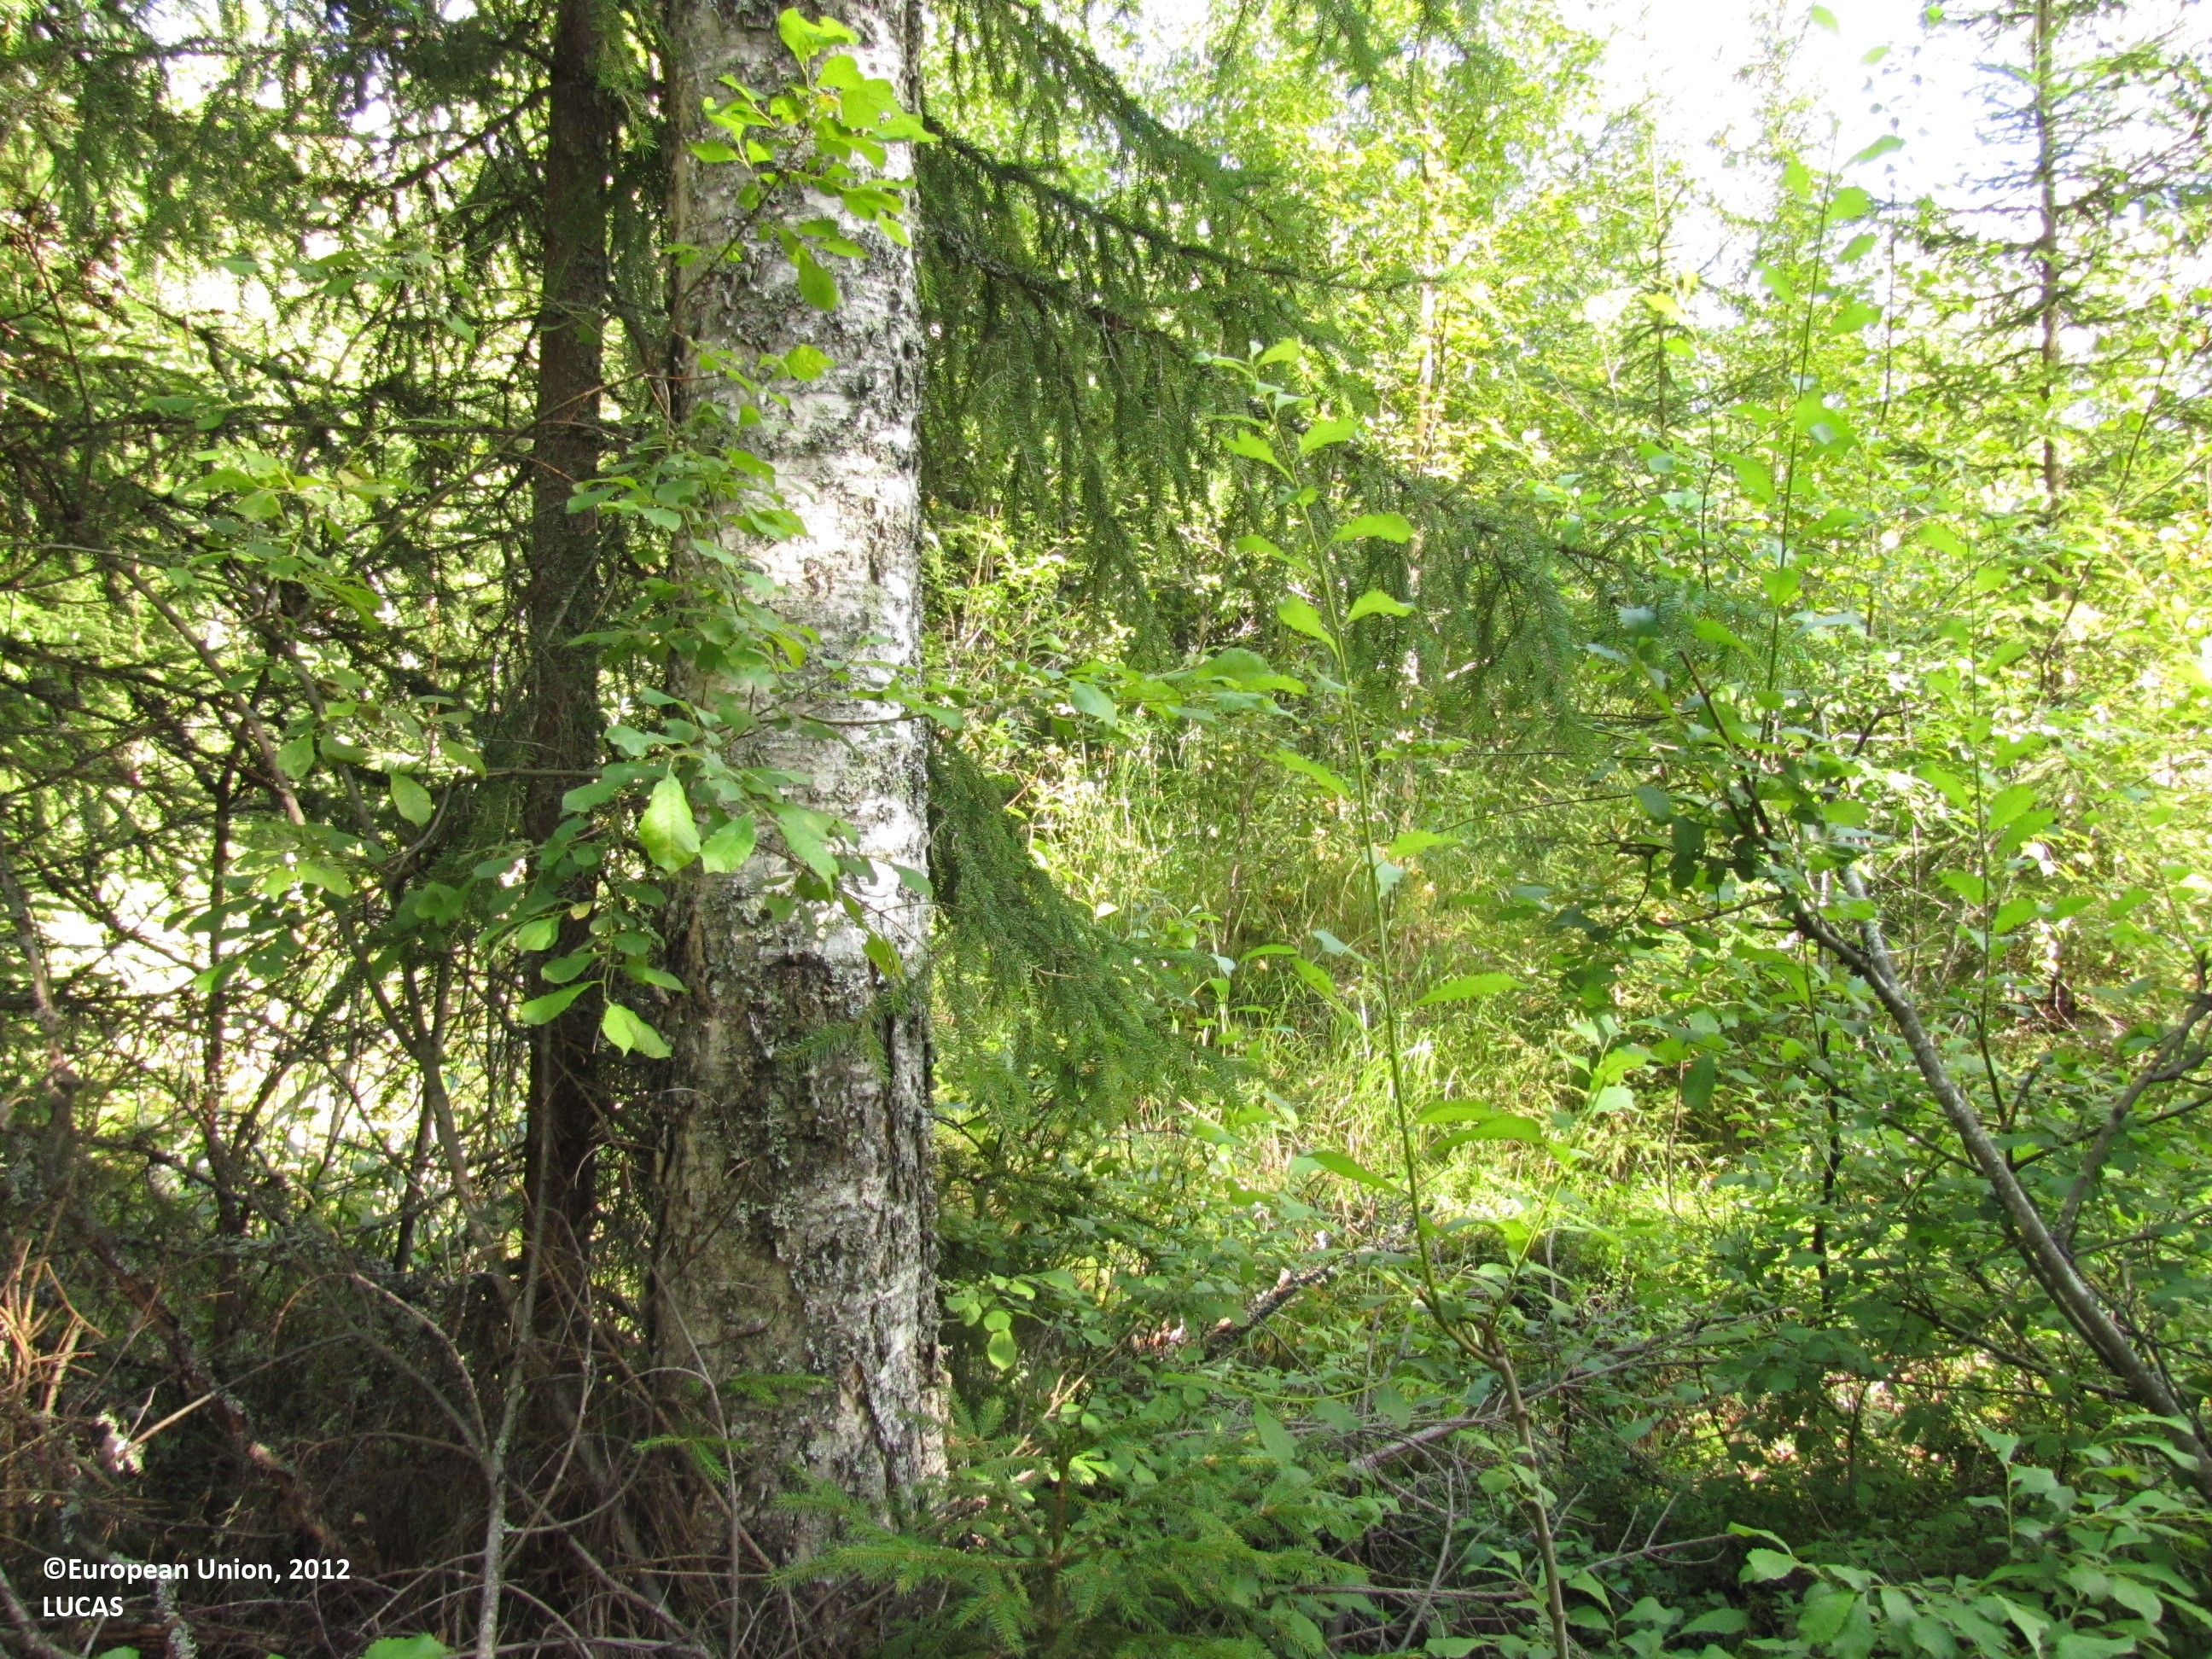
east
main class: Woodland
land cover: Spruce dominated mixed woodland
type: boreal forest
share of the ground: 50 - 75 %
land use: Forestry
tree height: > 5 m
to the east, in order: Spruce dominated mixed woodland; Spruce dominated coniferous woodland; Ditches and canals; Spruce dominated mixed woodland; Ditches and canals; Spruce dominated coniferous woodland; Ditches and canals; Spruce dominated coniferous woodland; Other mixed woodland
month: August
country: FI
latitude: 61.7622
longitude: 22.8940
